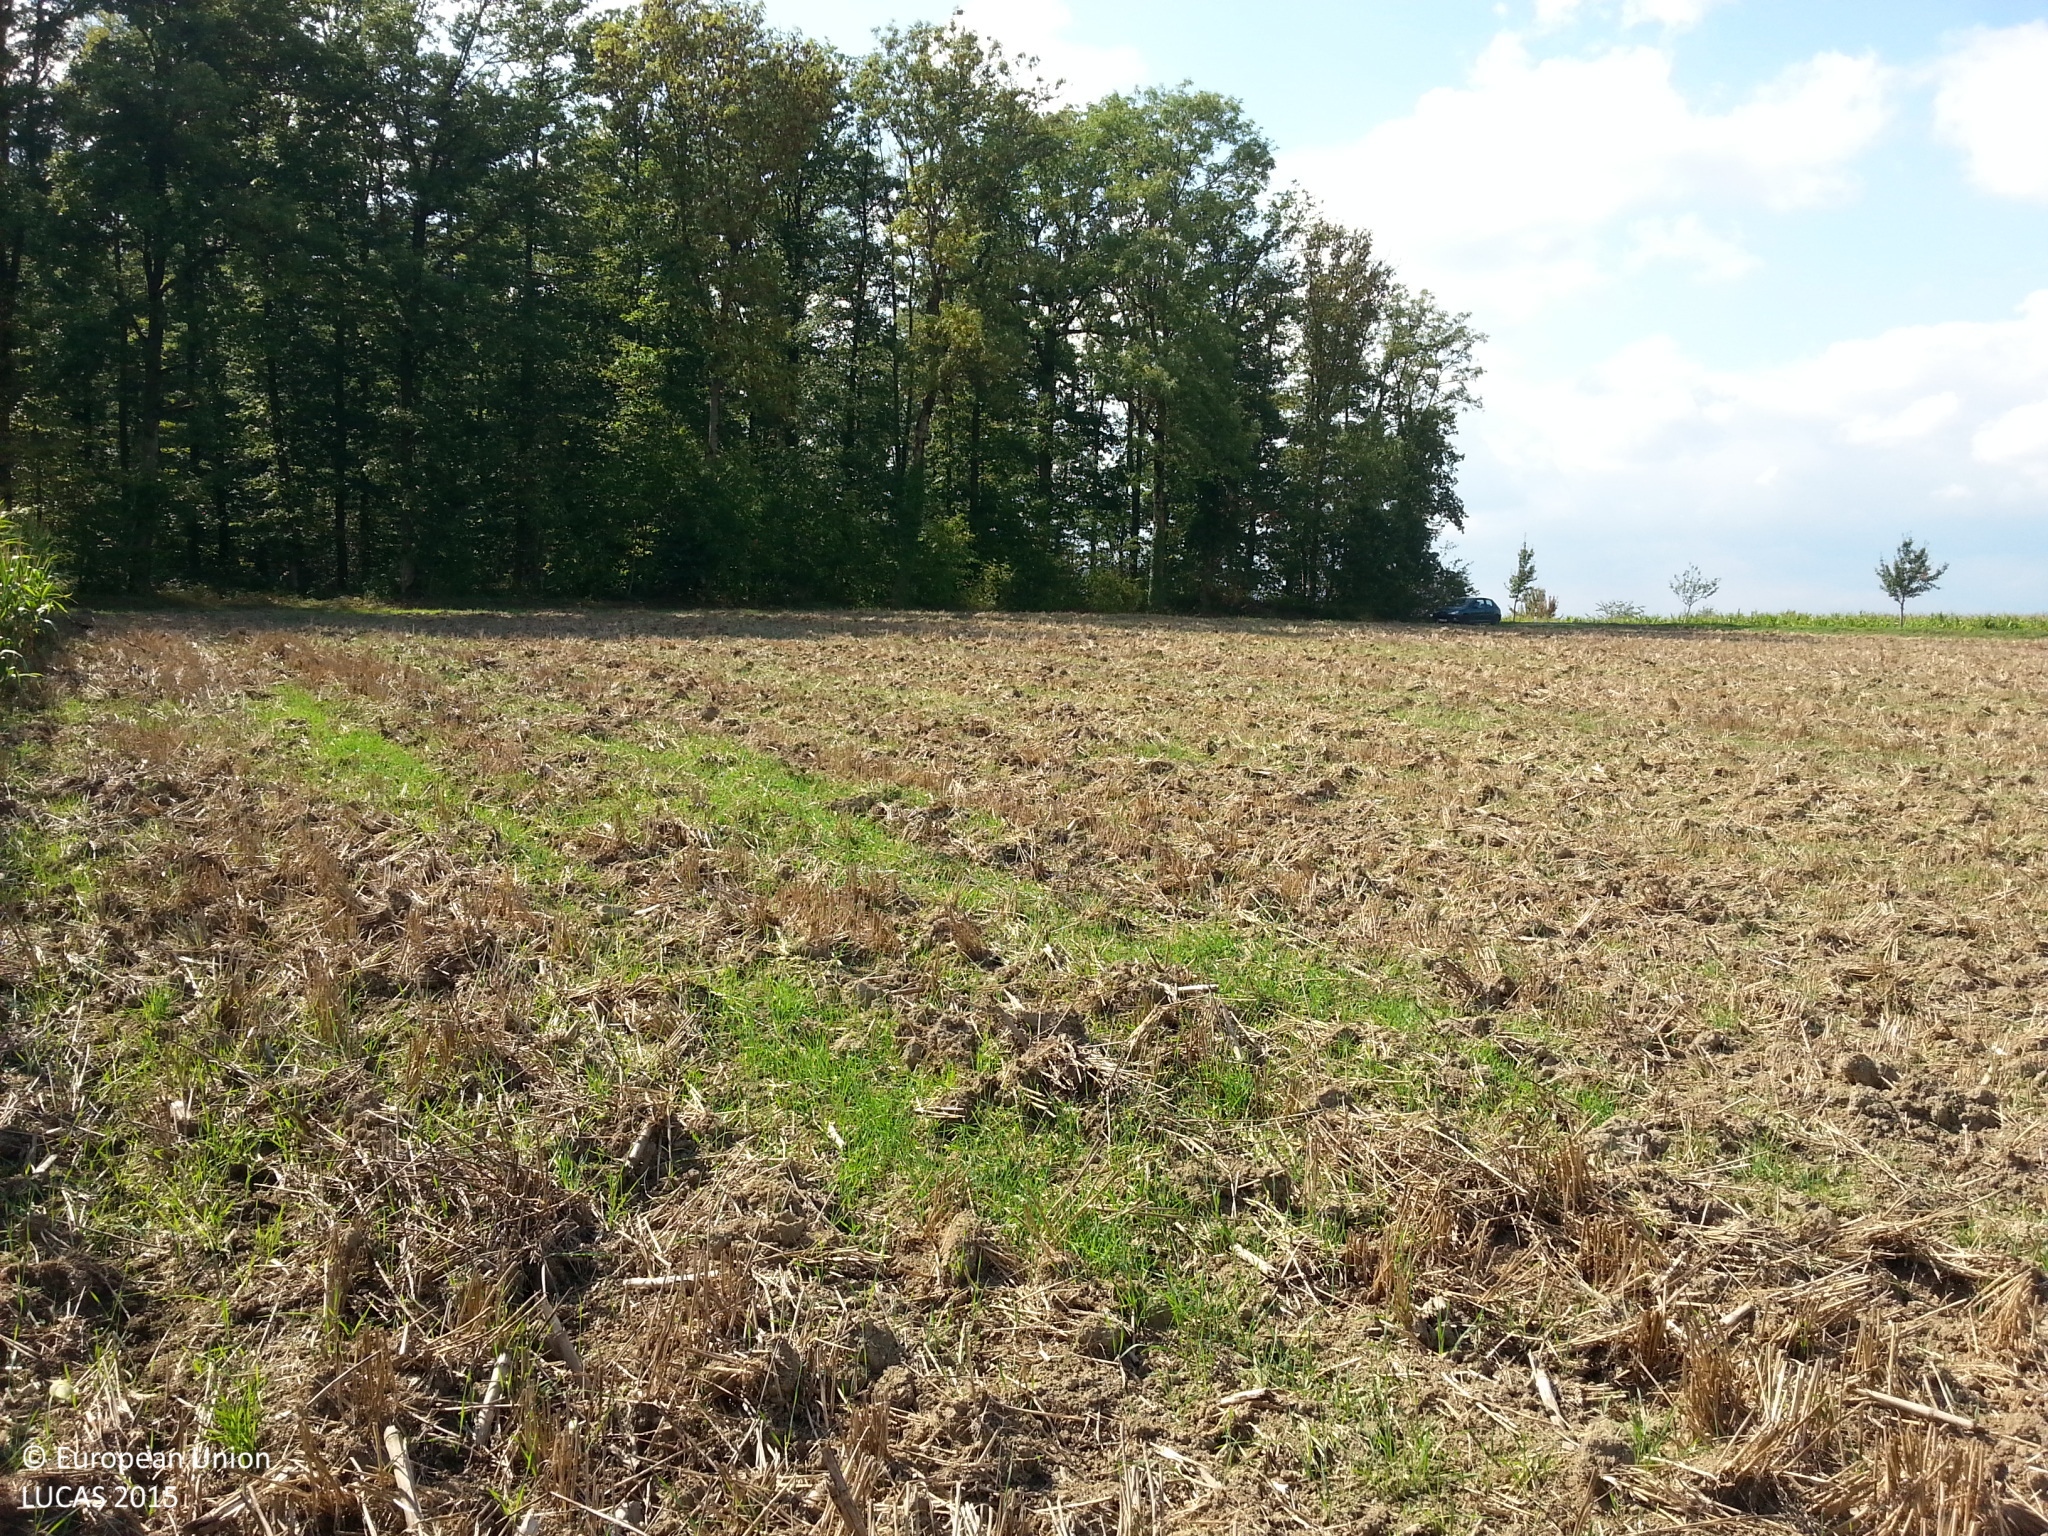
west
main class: Cropland
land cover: Maize
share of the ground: > 75 %
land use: Agriculture (excluding fallow land and kitchen gardens)
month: September
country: DE
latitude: 49.3569
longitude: 9.9037
